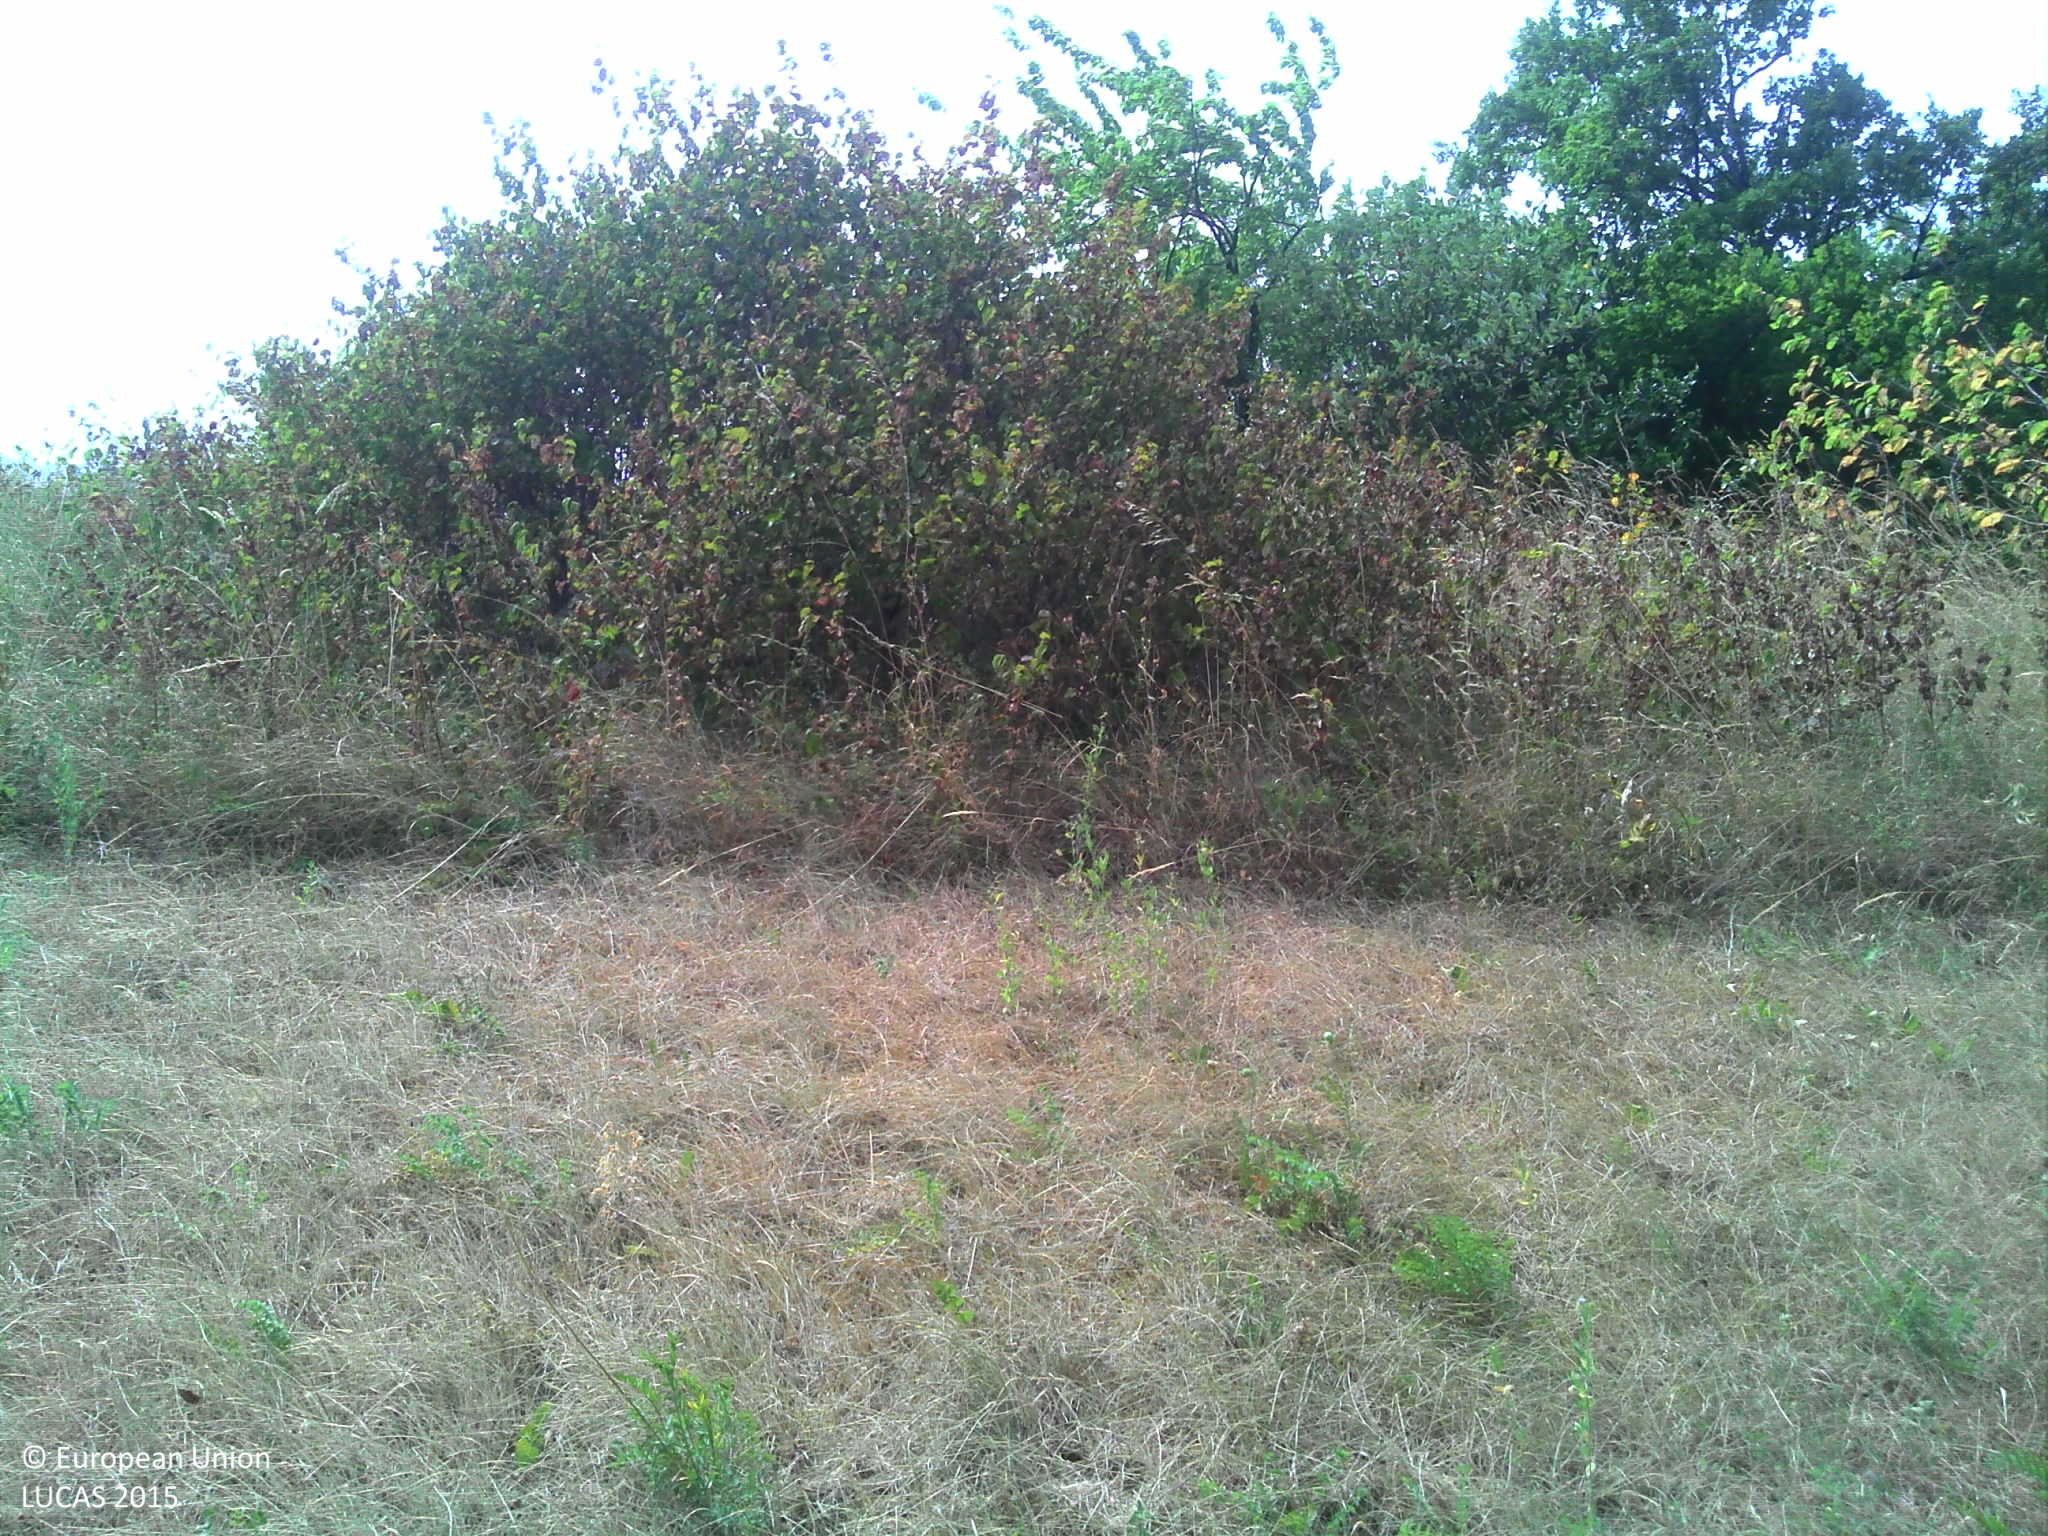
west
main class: Grassland
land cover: Grassland with sparse tree/shrub cover
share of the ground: > 75 %
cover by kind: herbaceous plants 90 %, broadleaved forest trees 5 %, shrubs 5 %
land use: Semi-natural and natural areas not in use
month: July
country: FR
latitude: 45.8151
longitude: 6.2076
